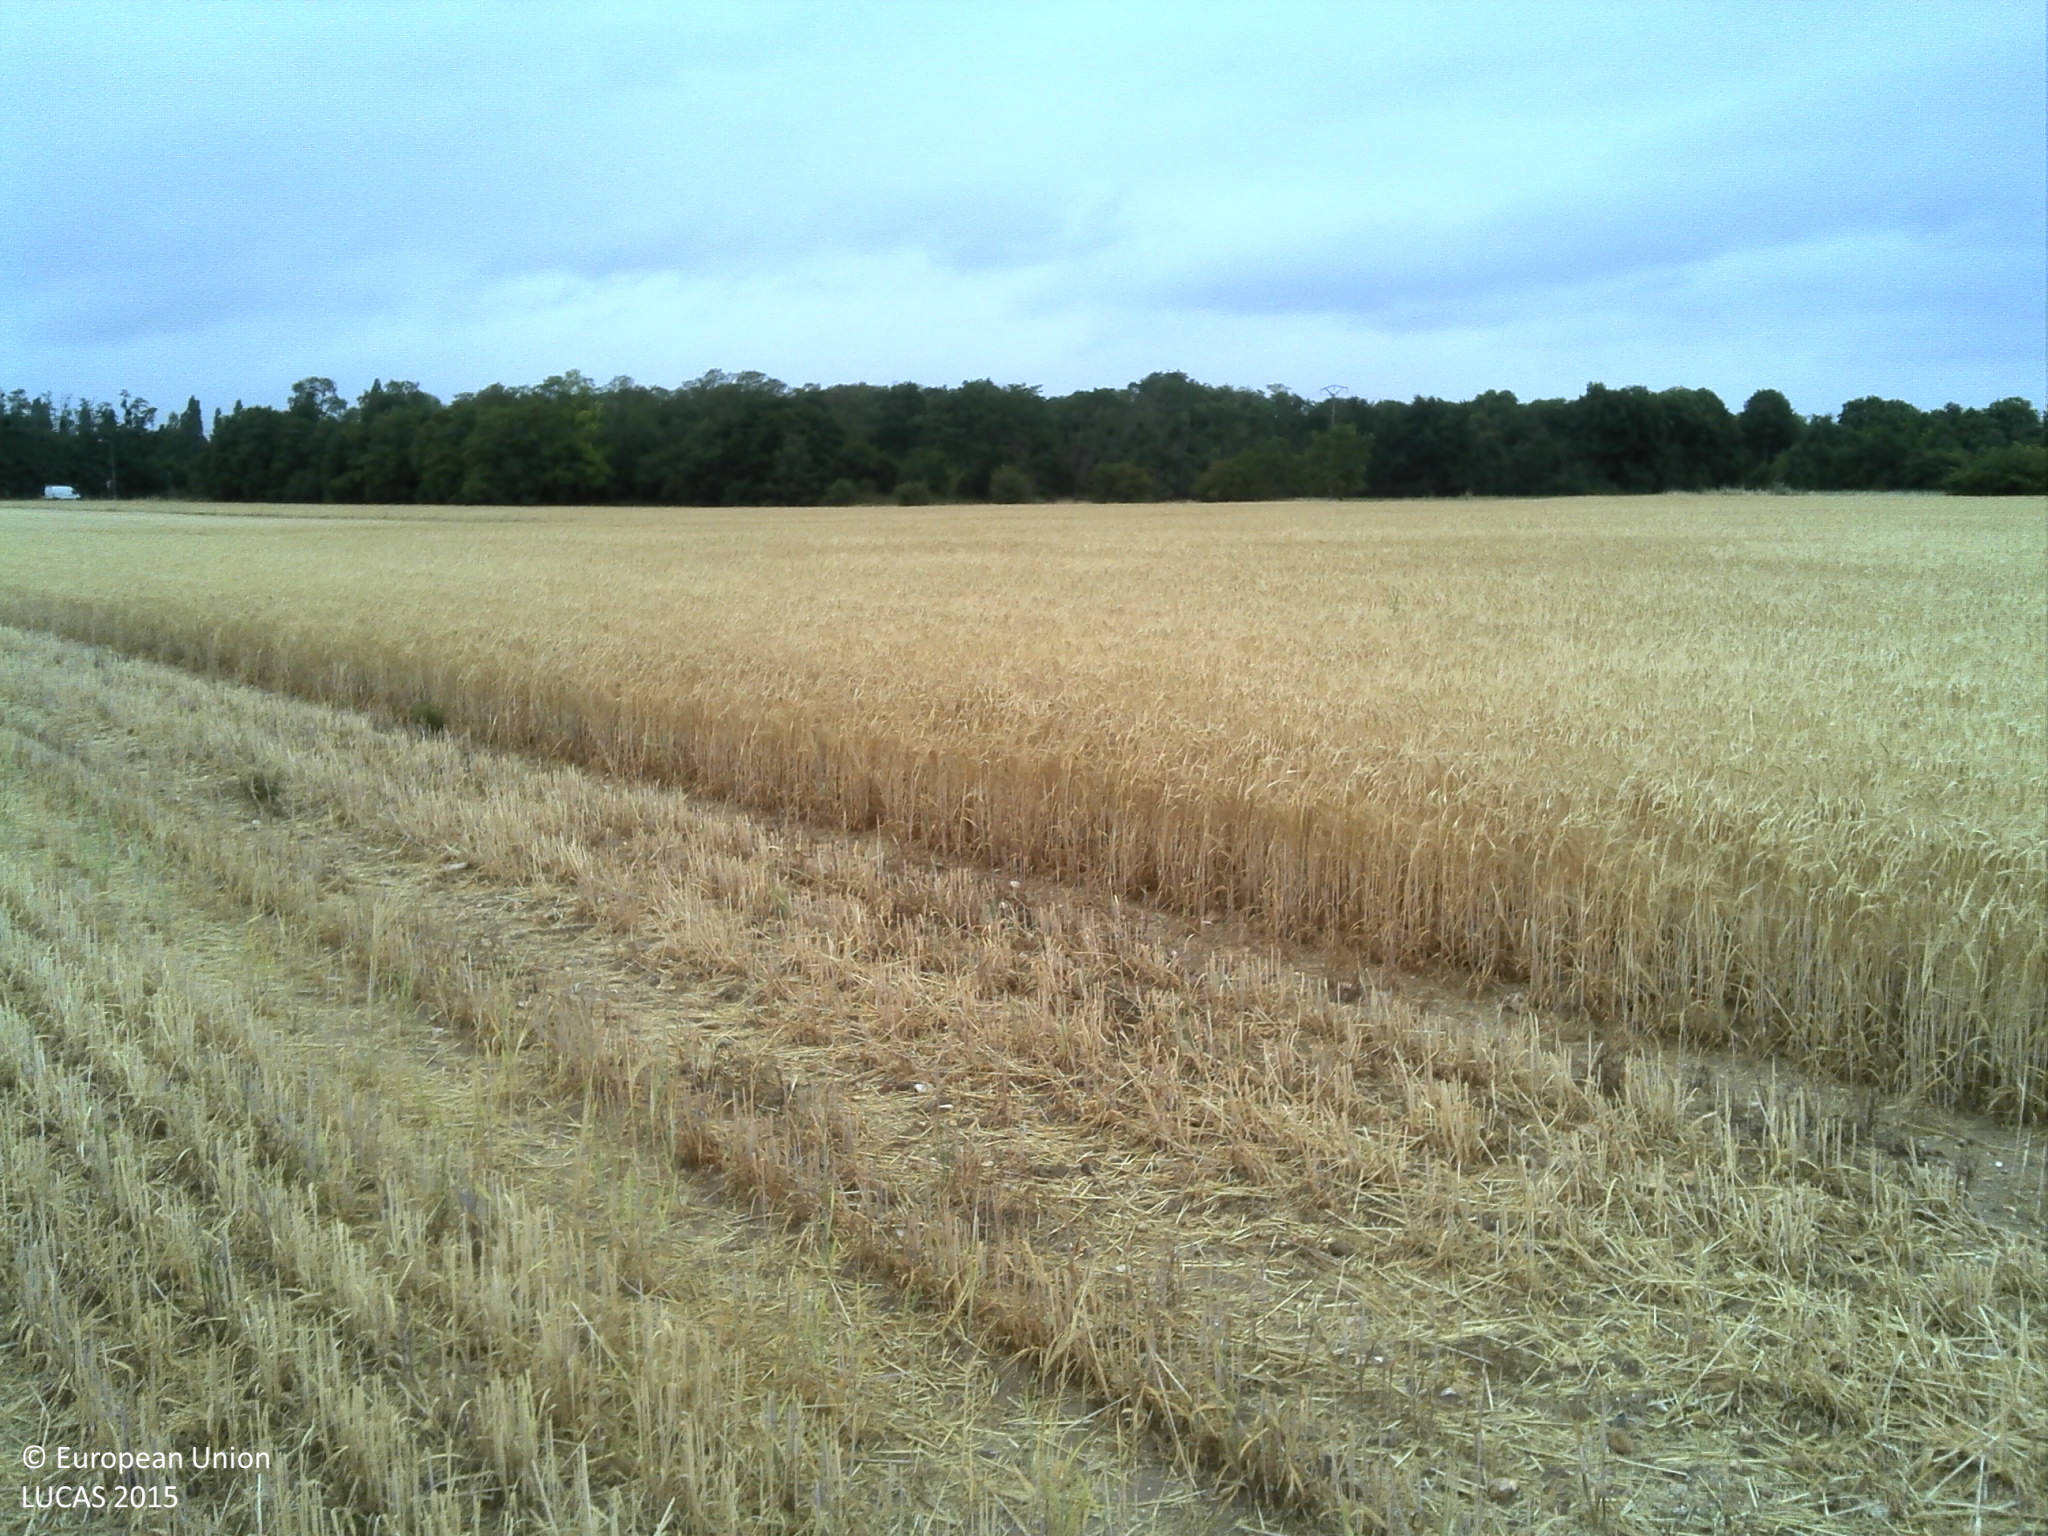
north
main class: Cropland
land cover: Barley
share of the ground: > 75 %
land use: Agriculture (excluding fallow land and kitchen gardens)
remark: Harvested field
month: July
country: FR
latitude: 48.9727
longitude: 1.8837
